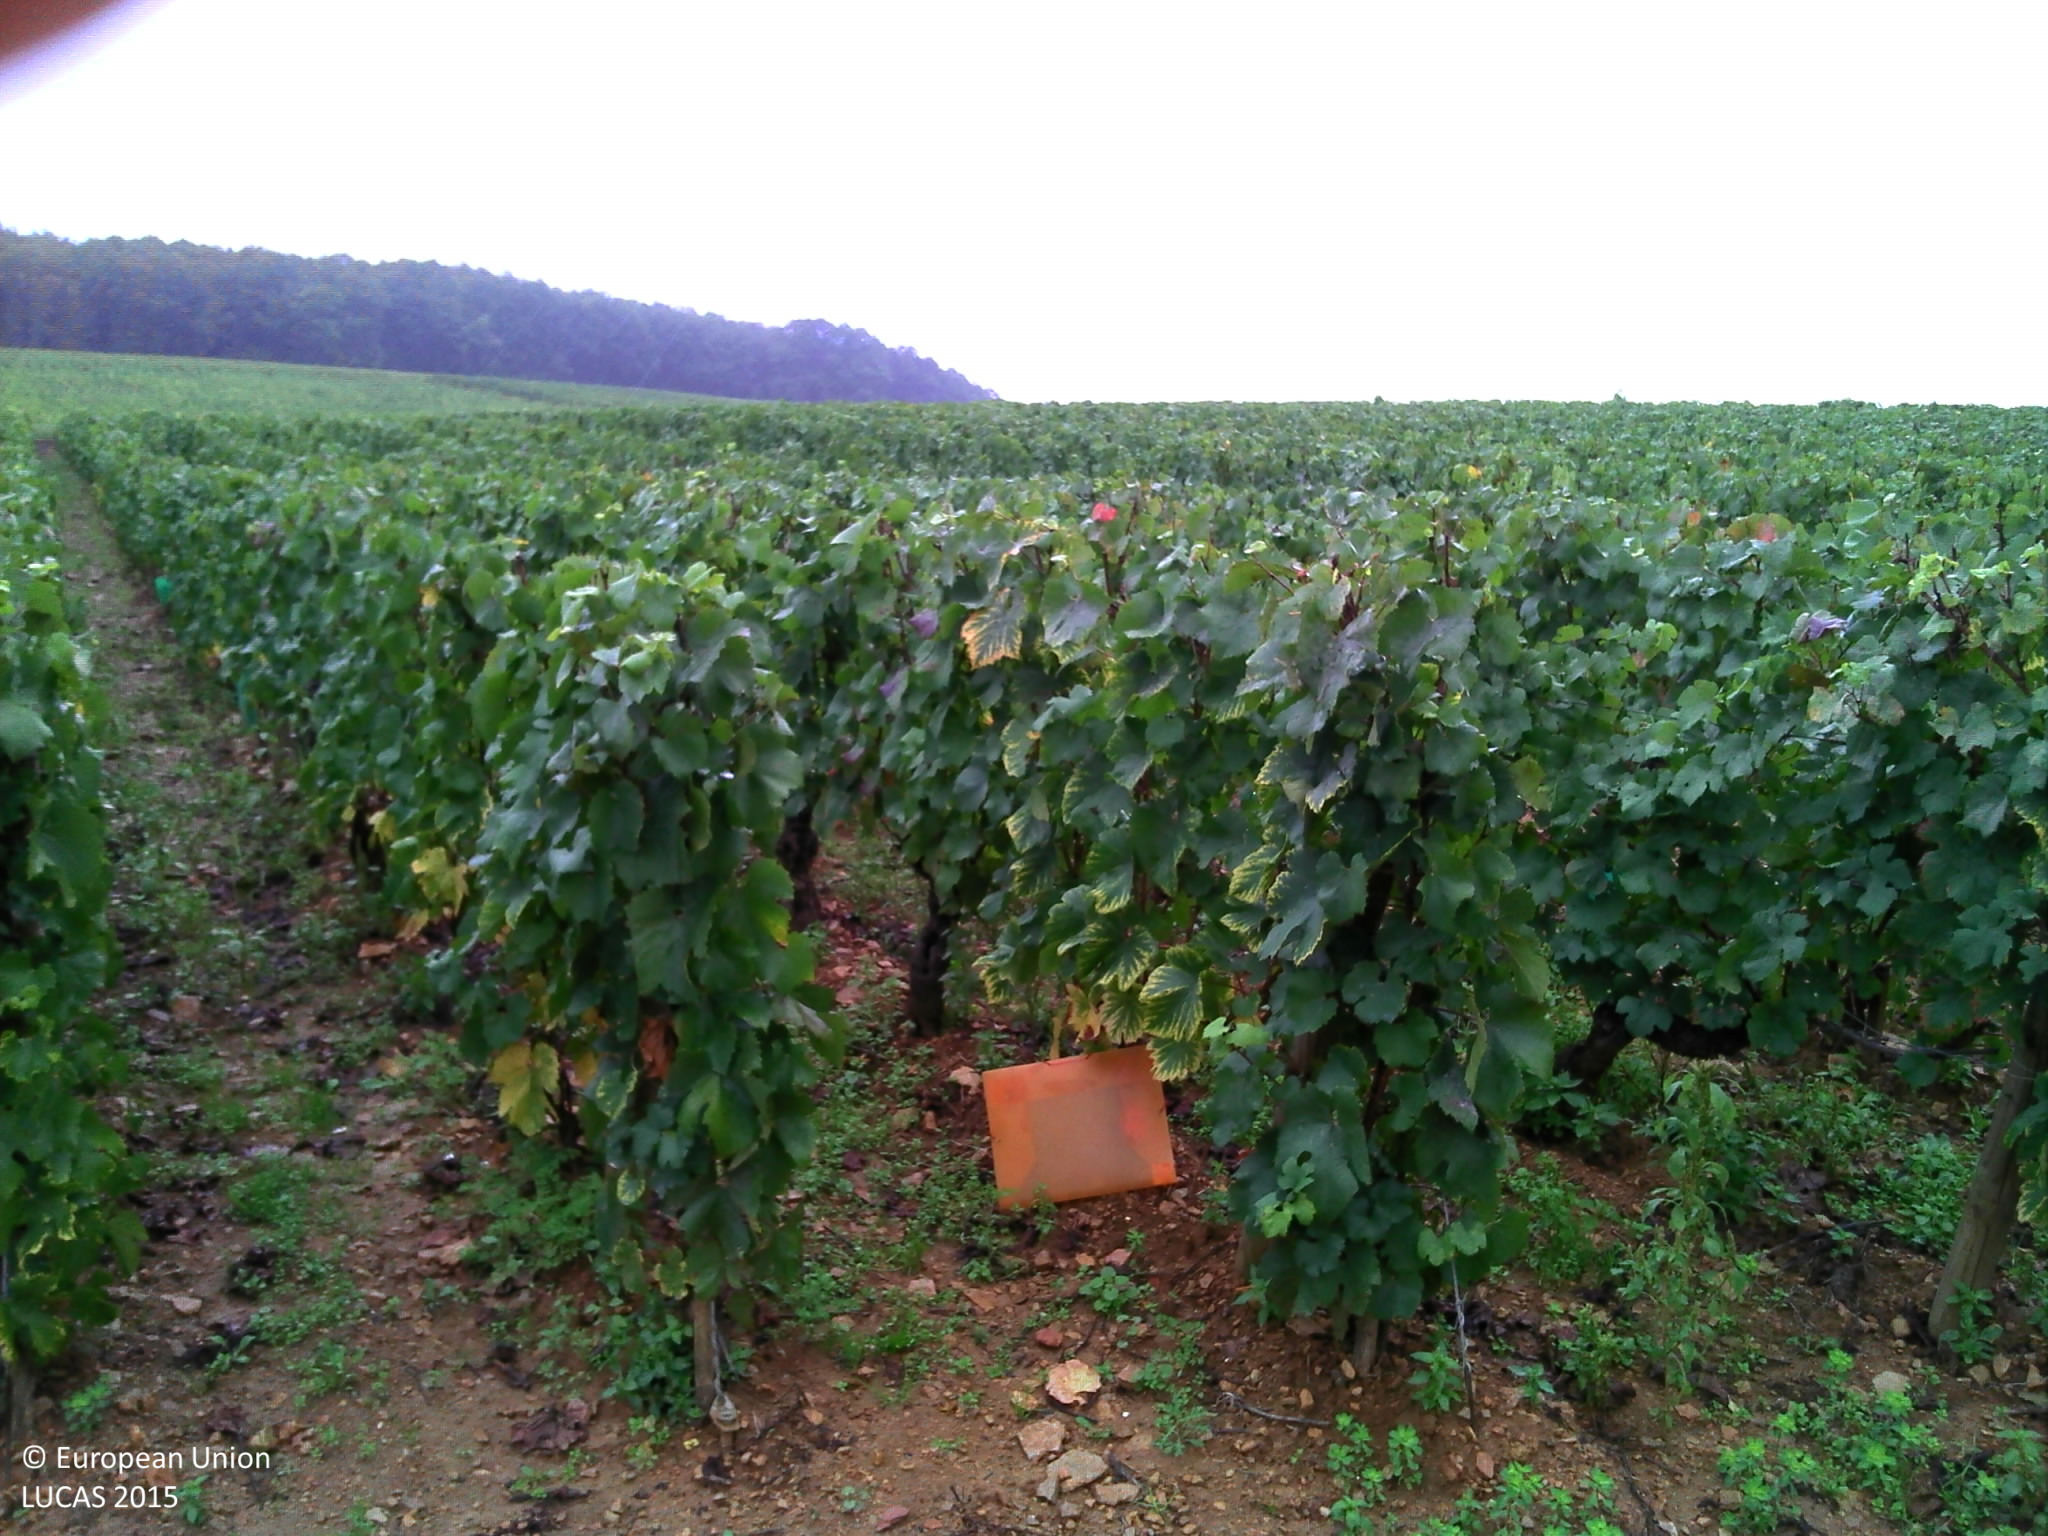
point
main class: Cropland
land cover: Vineyards
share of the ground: 10 - 25 %
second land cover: Other bare soil
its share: > 75 %
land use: Agriculture (excluding fallow land and kitchen gardens)
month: September
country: FR
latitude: 47.0753
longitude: 4.8514
